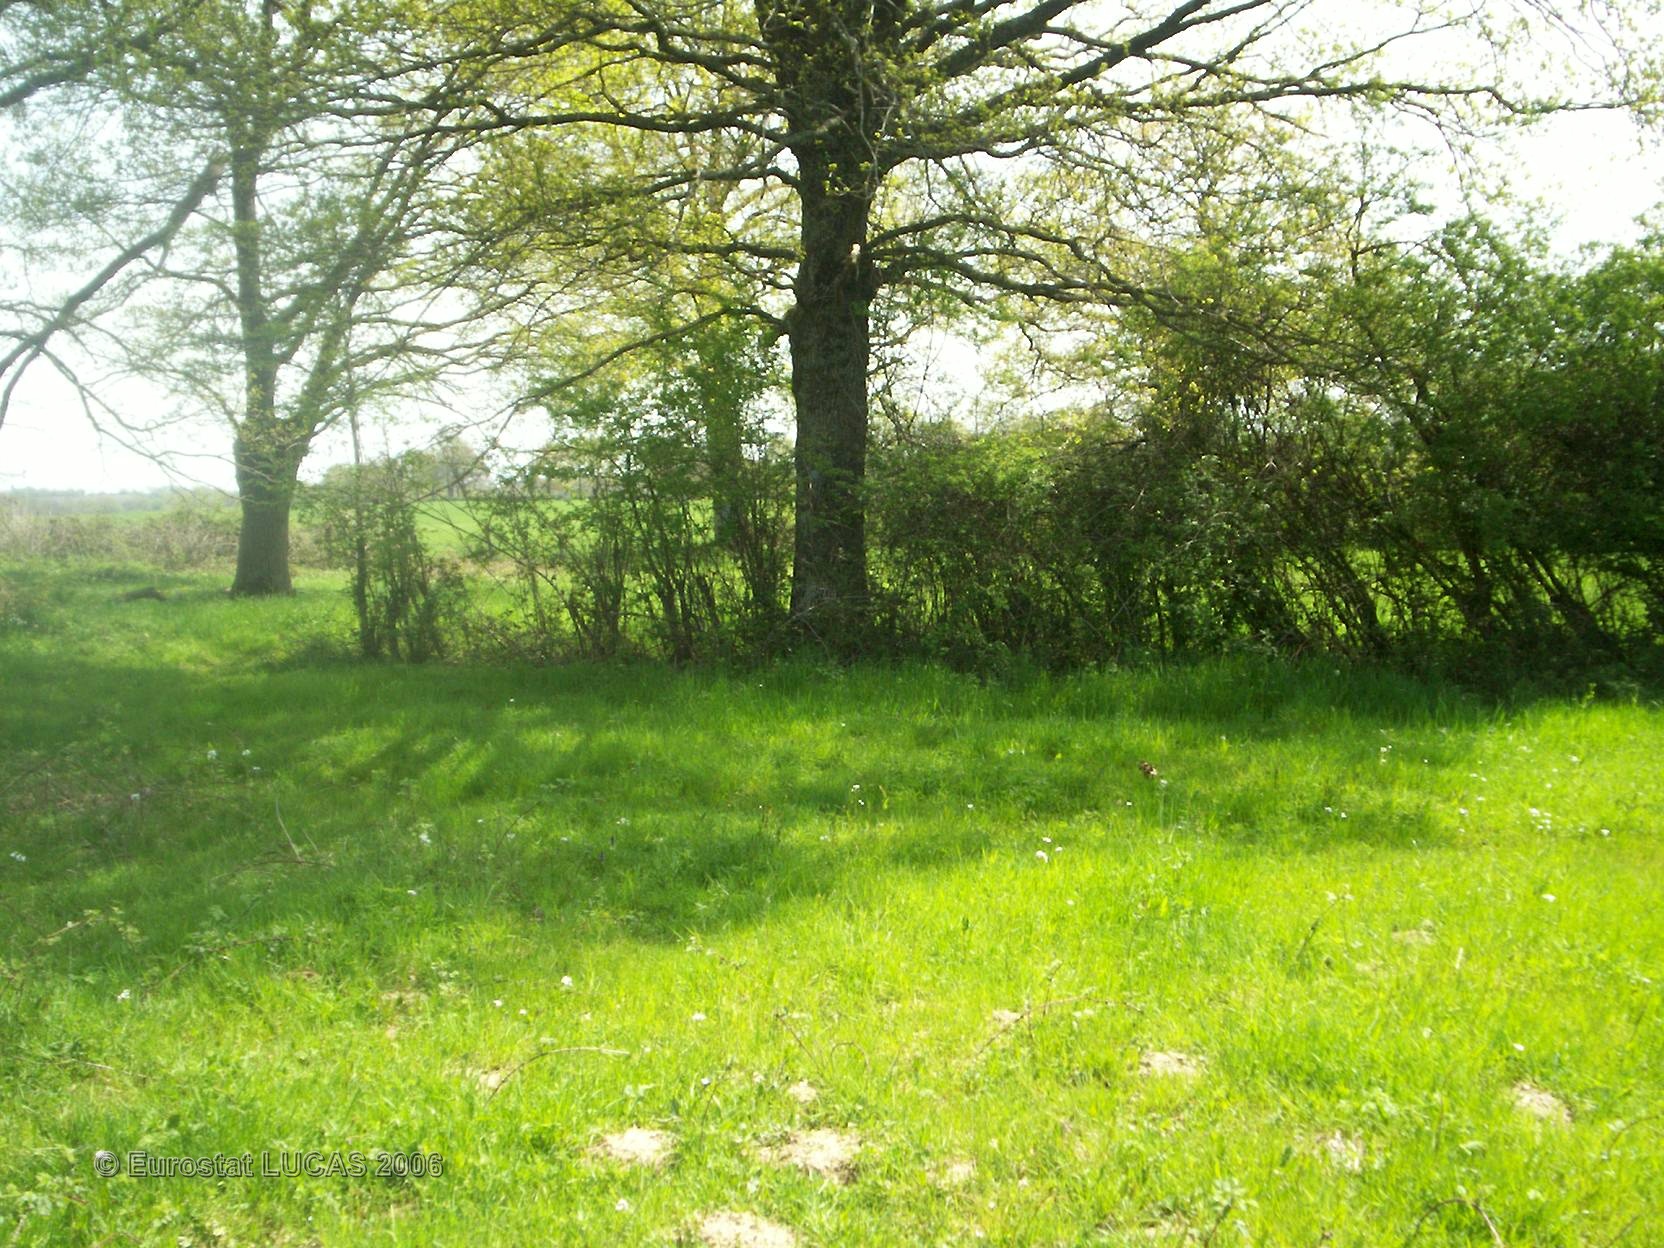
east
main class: Grassland
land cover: Grassland with sparse tree/shrub cover
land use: Agriculture (excluding fallow land and kitchen gardens)
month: May
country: FR
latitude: 46.3792
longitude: 3.0679
